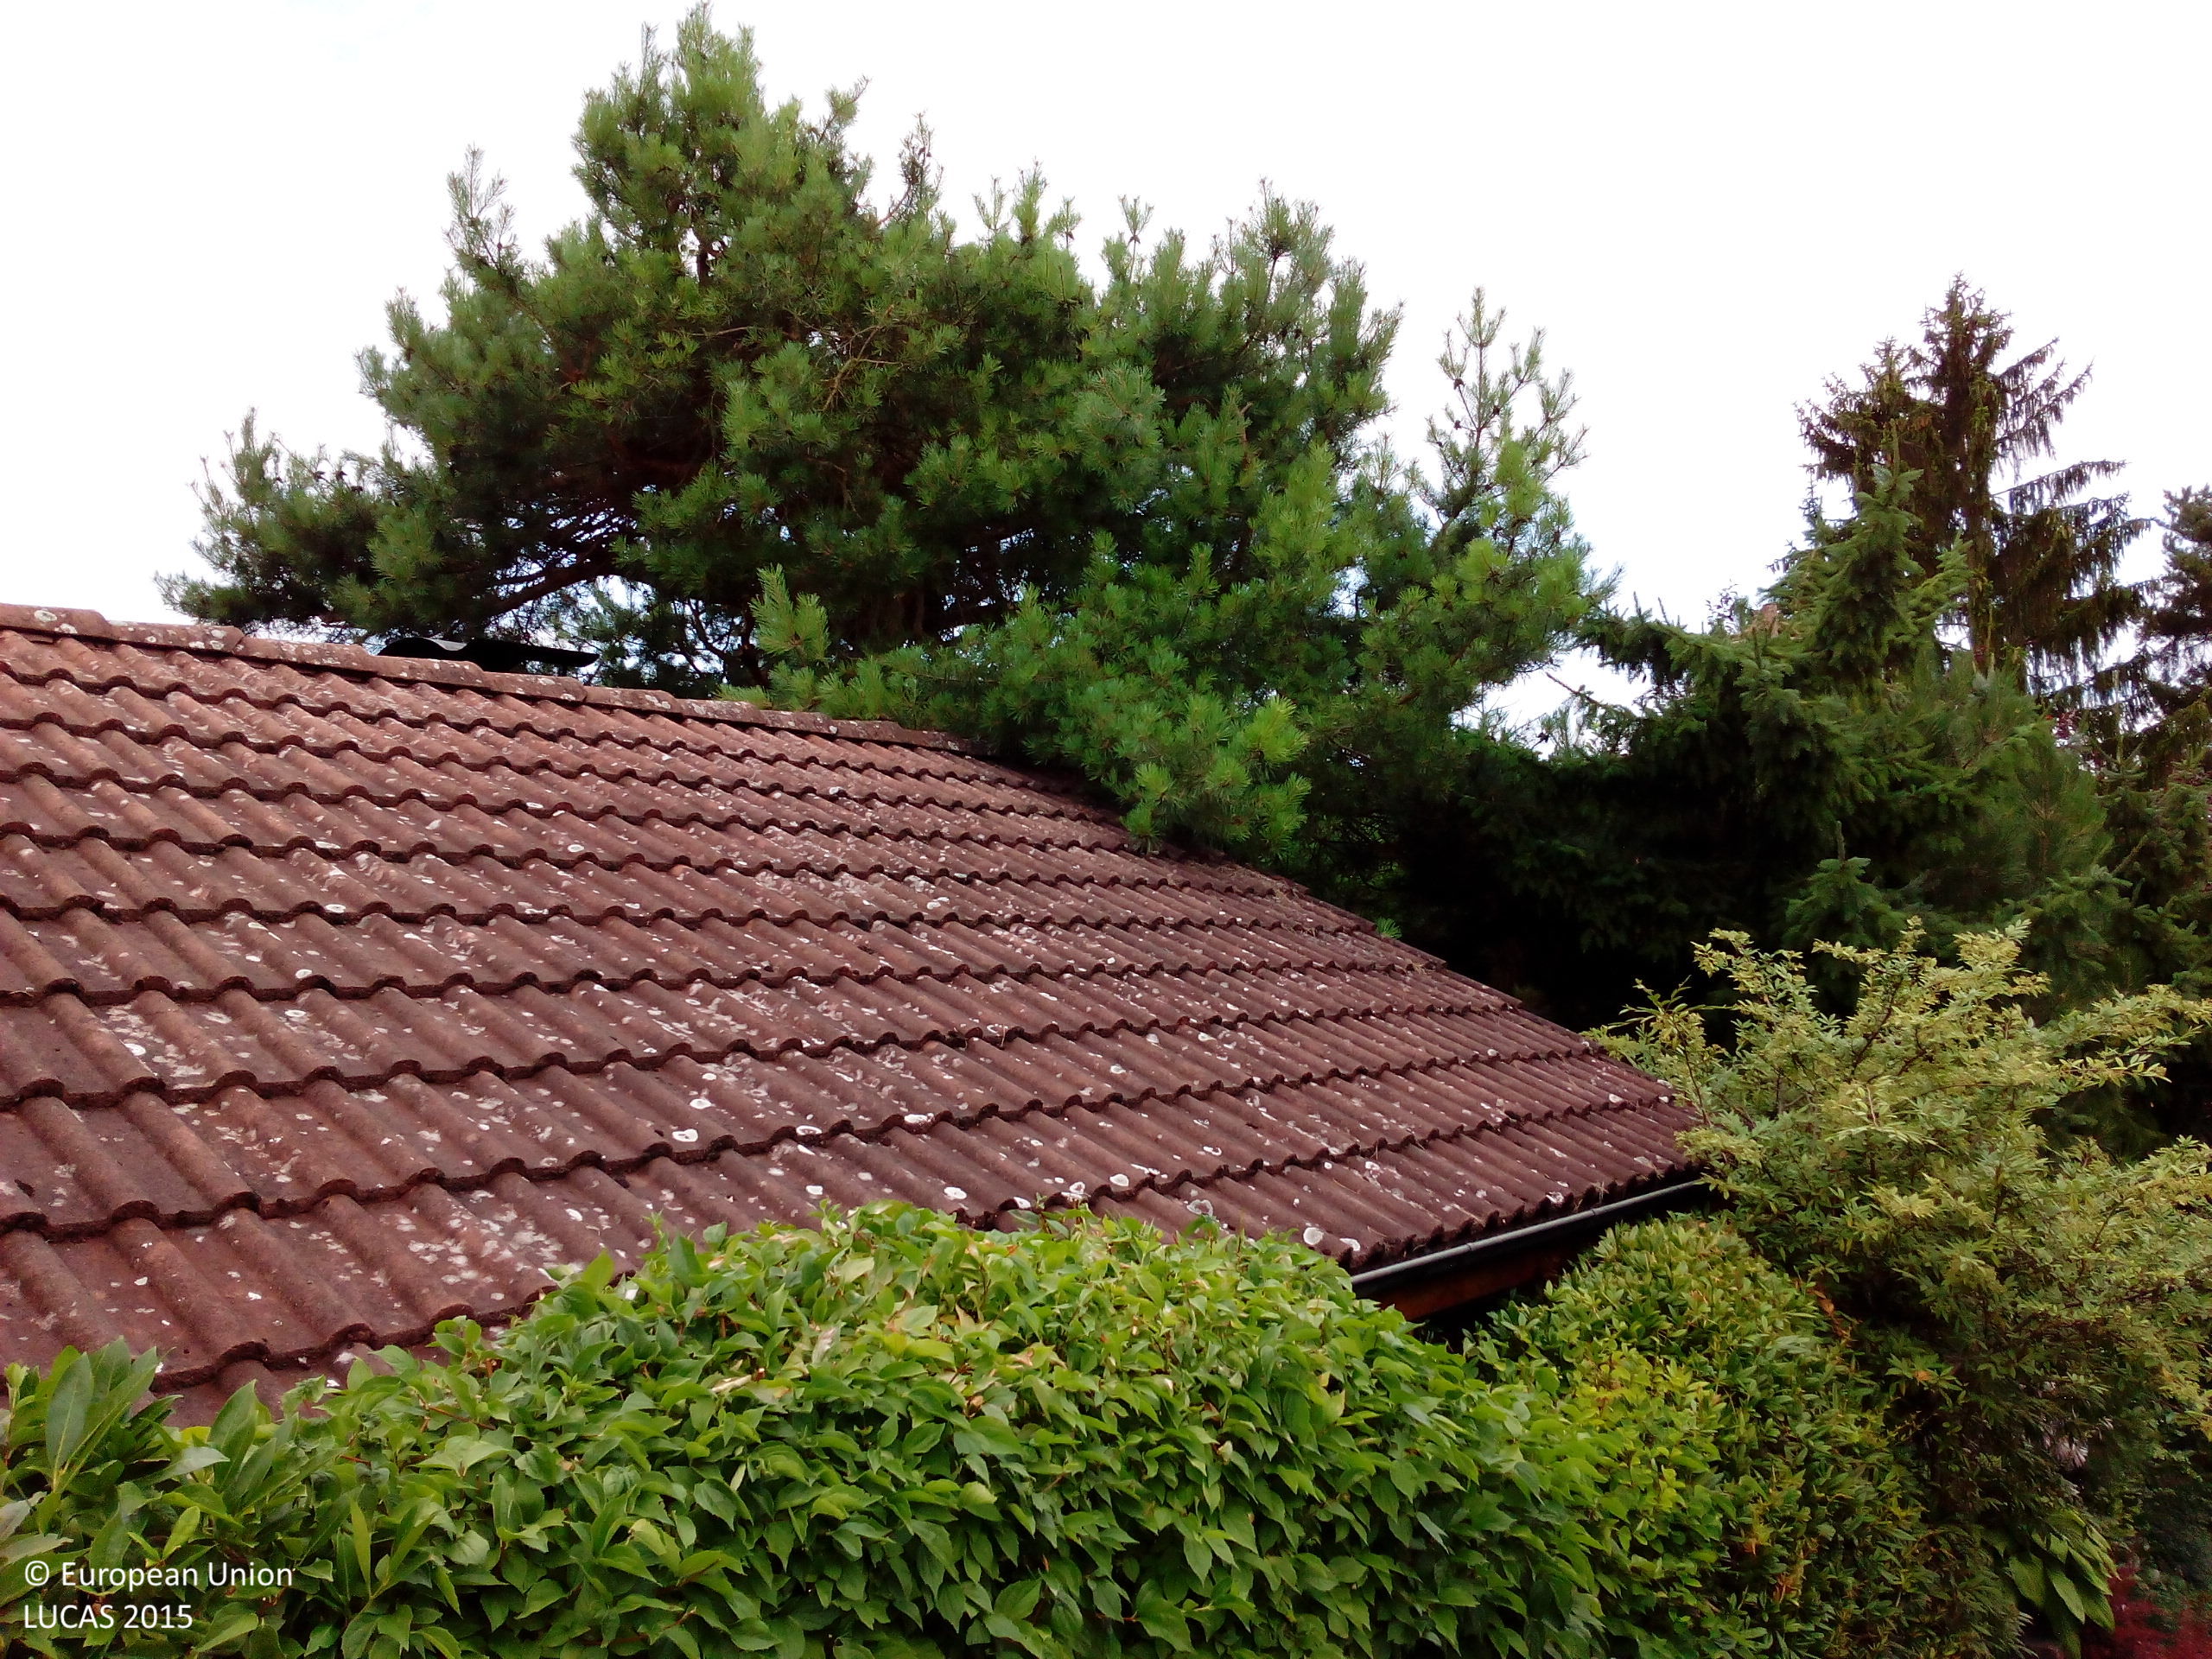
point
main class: Woodland
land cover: Other coniferous woodland
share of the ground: 50 - 75 %
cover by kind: coniferous forest trees 60 %, shrubs 30 %, herbaceous plants 5 %, consolidated bare surface 5 %
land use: Residential
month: July
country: DE
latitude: 47.6403
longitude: 7.6455
